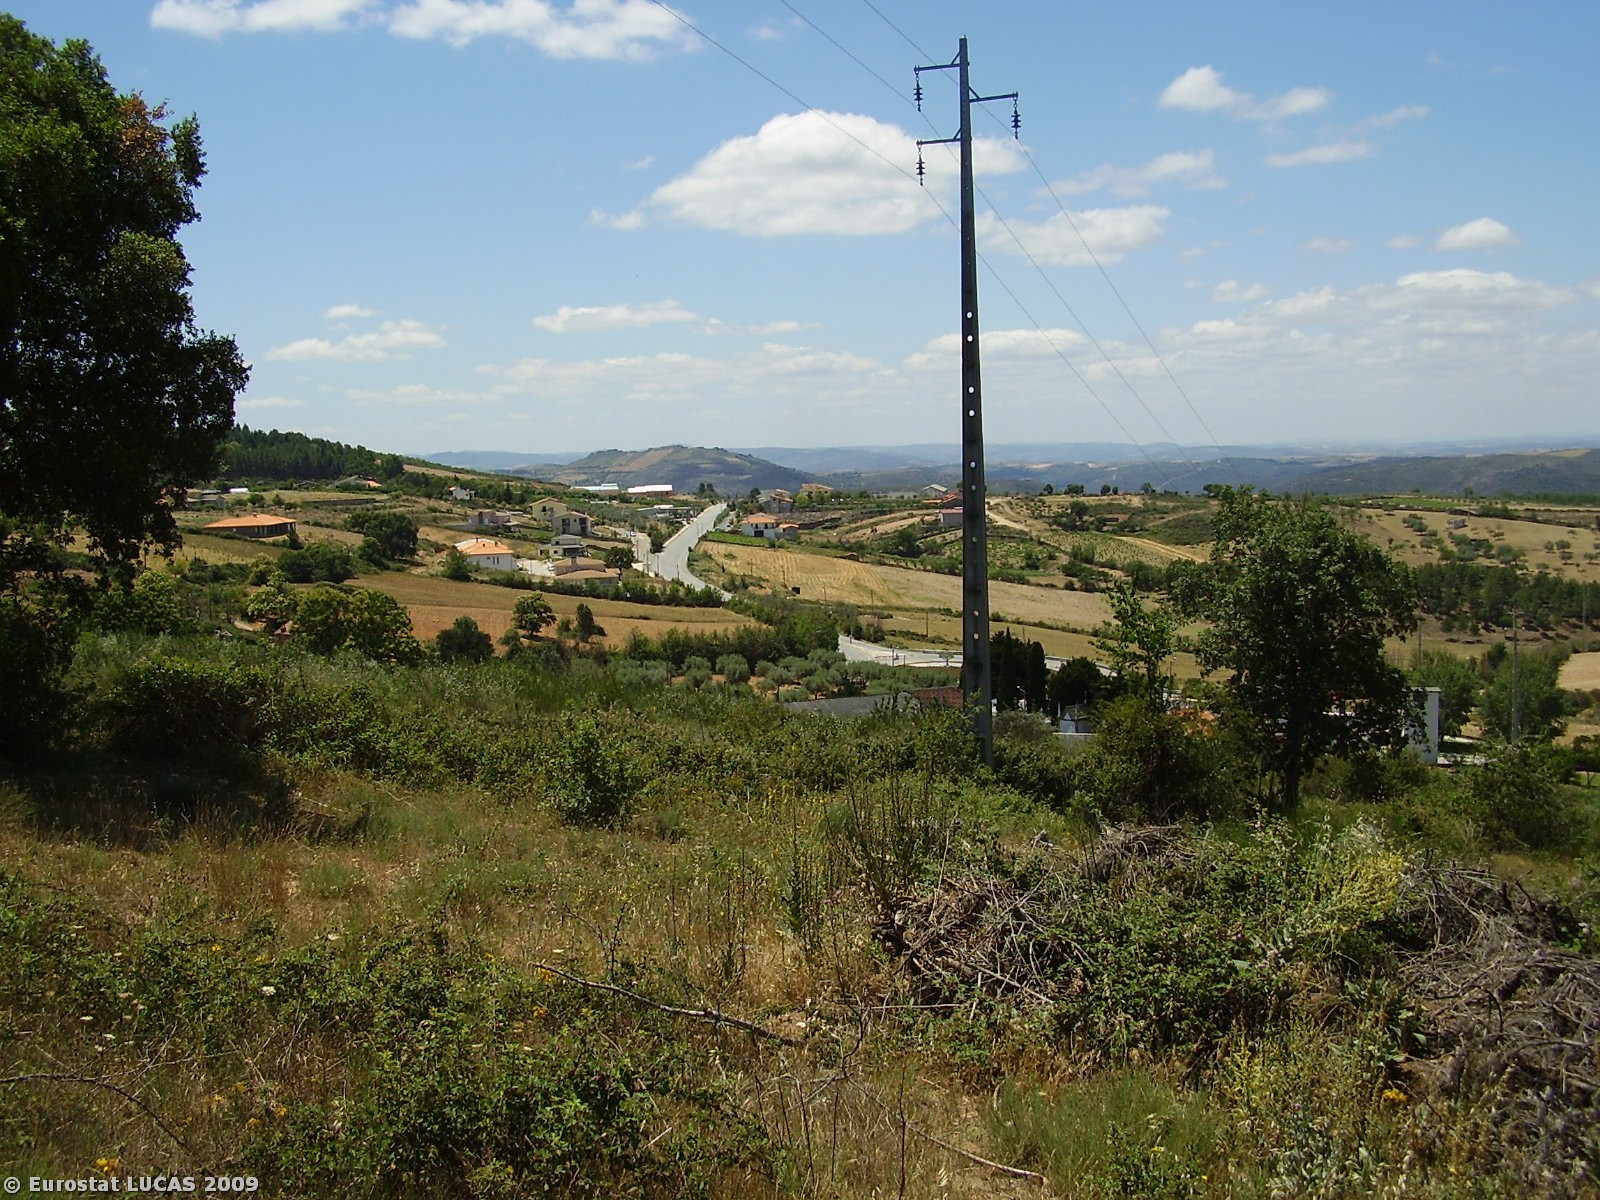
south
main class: Shrubland
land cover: Shrubland with sparse tree cover
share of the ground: 10 - 25 %
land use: Unused
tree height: > 5 m
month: June
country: PT
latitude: 41.5801
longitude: -6.5246
